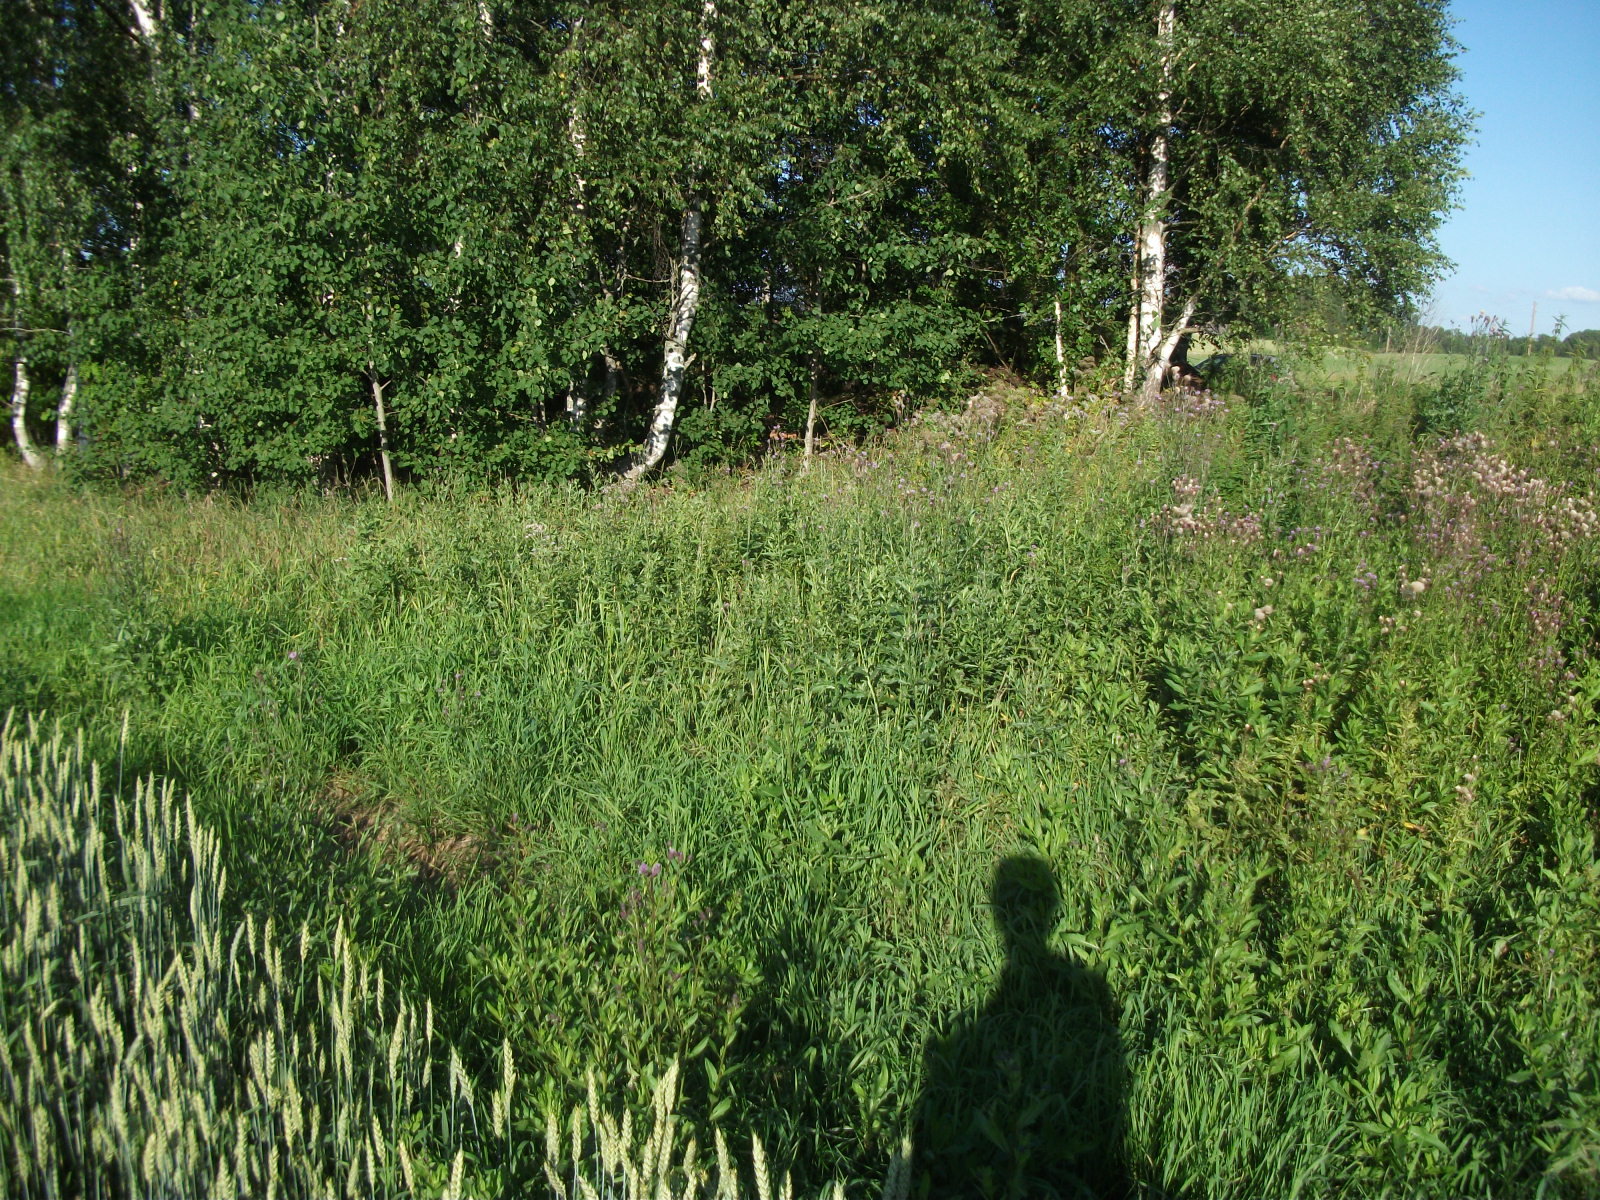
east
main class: Cropland
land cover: Common wheat
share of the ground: > 75 %
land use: Agriculture (excluding fallow land and kitchen gardens)
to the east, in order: Common wheat; Spontaneously vegetated surfaces; Broadleaved woodland; Artificial constructions in urban areas; Spontaneously vegetated surfaces; Paved roads, cycling and walking lanes; Grass margins; Ditches and canals; Grass margins; Barley; Grass margins; Tracks; Grass margins; Common wheat
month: August
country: LV
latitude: 57.0921
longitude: 26.5338
